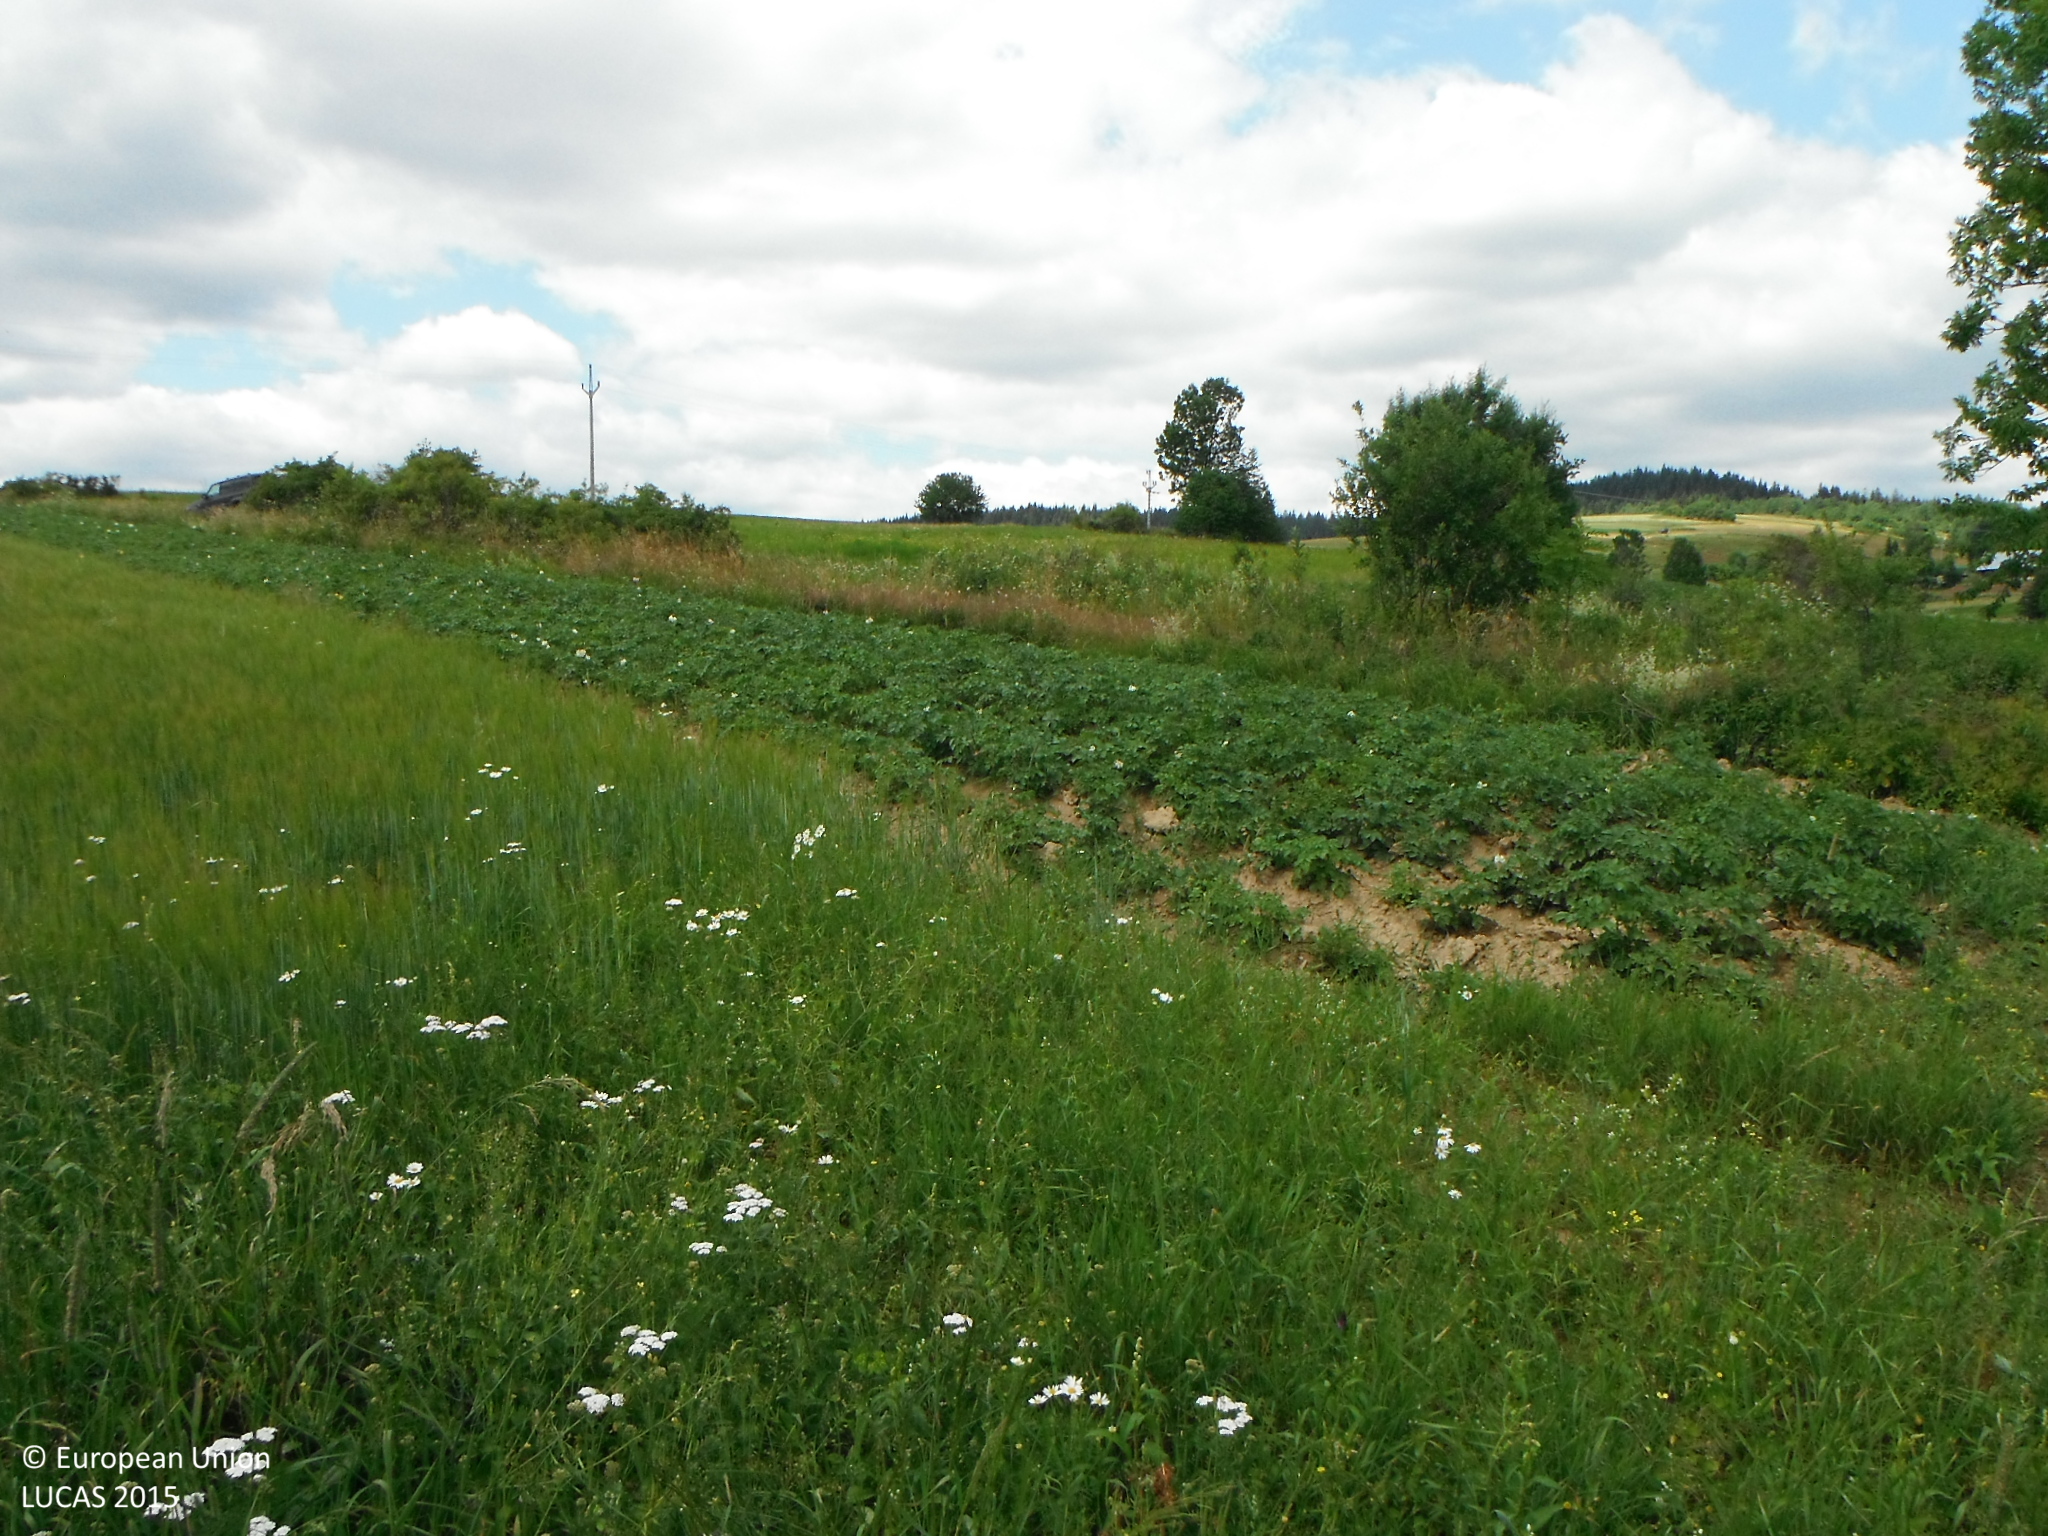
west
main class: Grassland
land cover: Grassland without tree/shrub cover
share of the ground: > 75 %
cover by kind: herbaceous plants 100 %
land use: Agriculture (excluding fallow land and kitchen gardens)
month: July
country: SK
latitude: 49.4449
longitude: 19.4742
